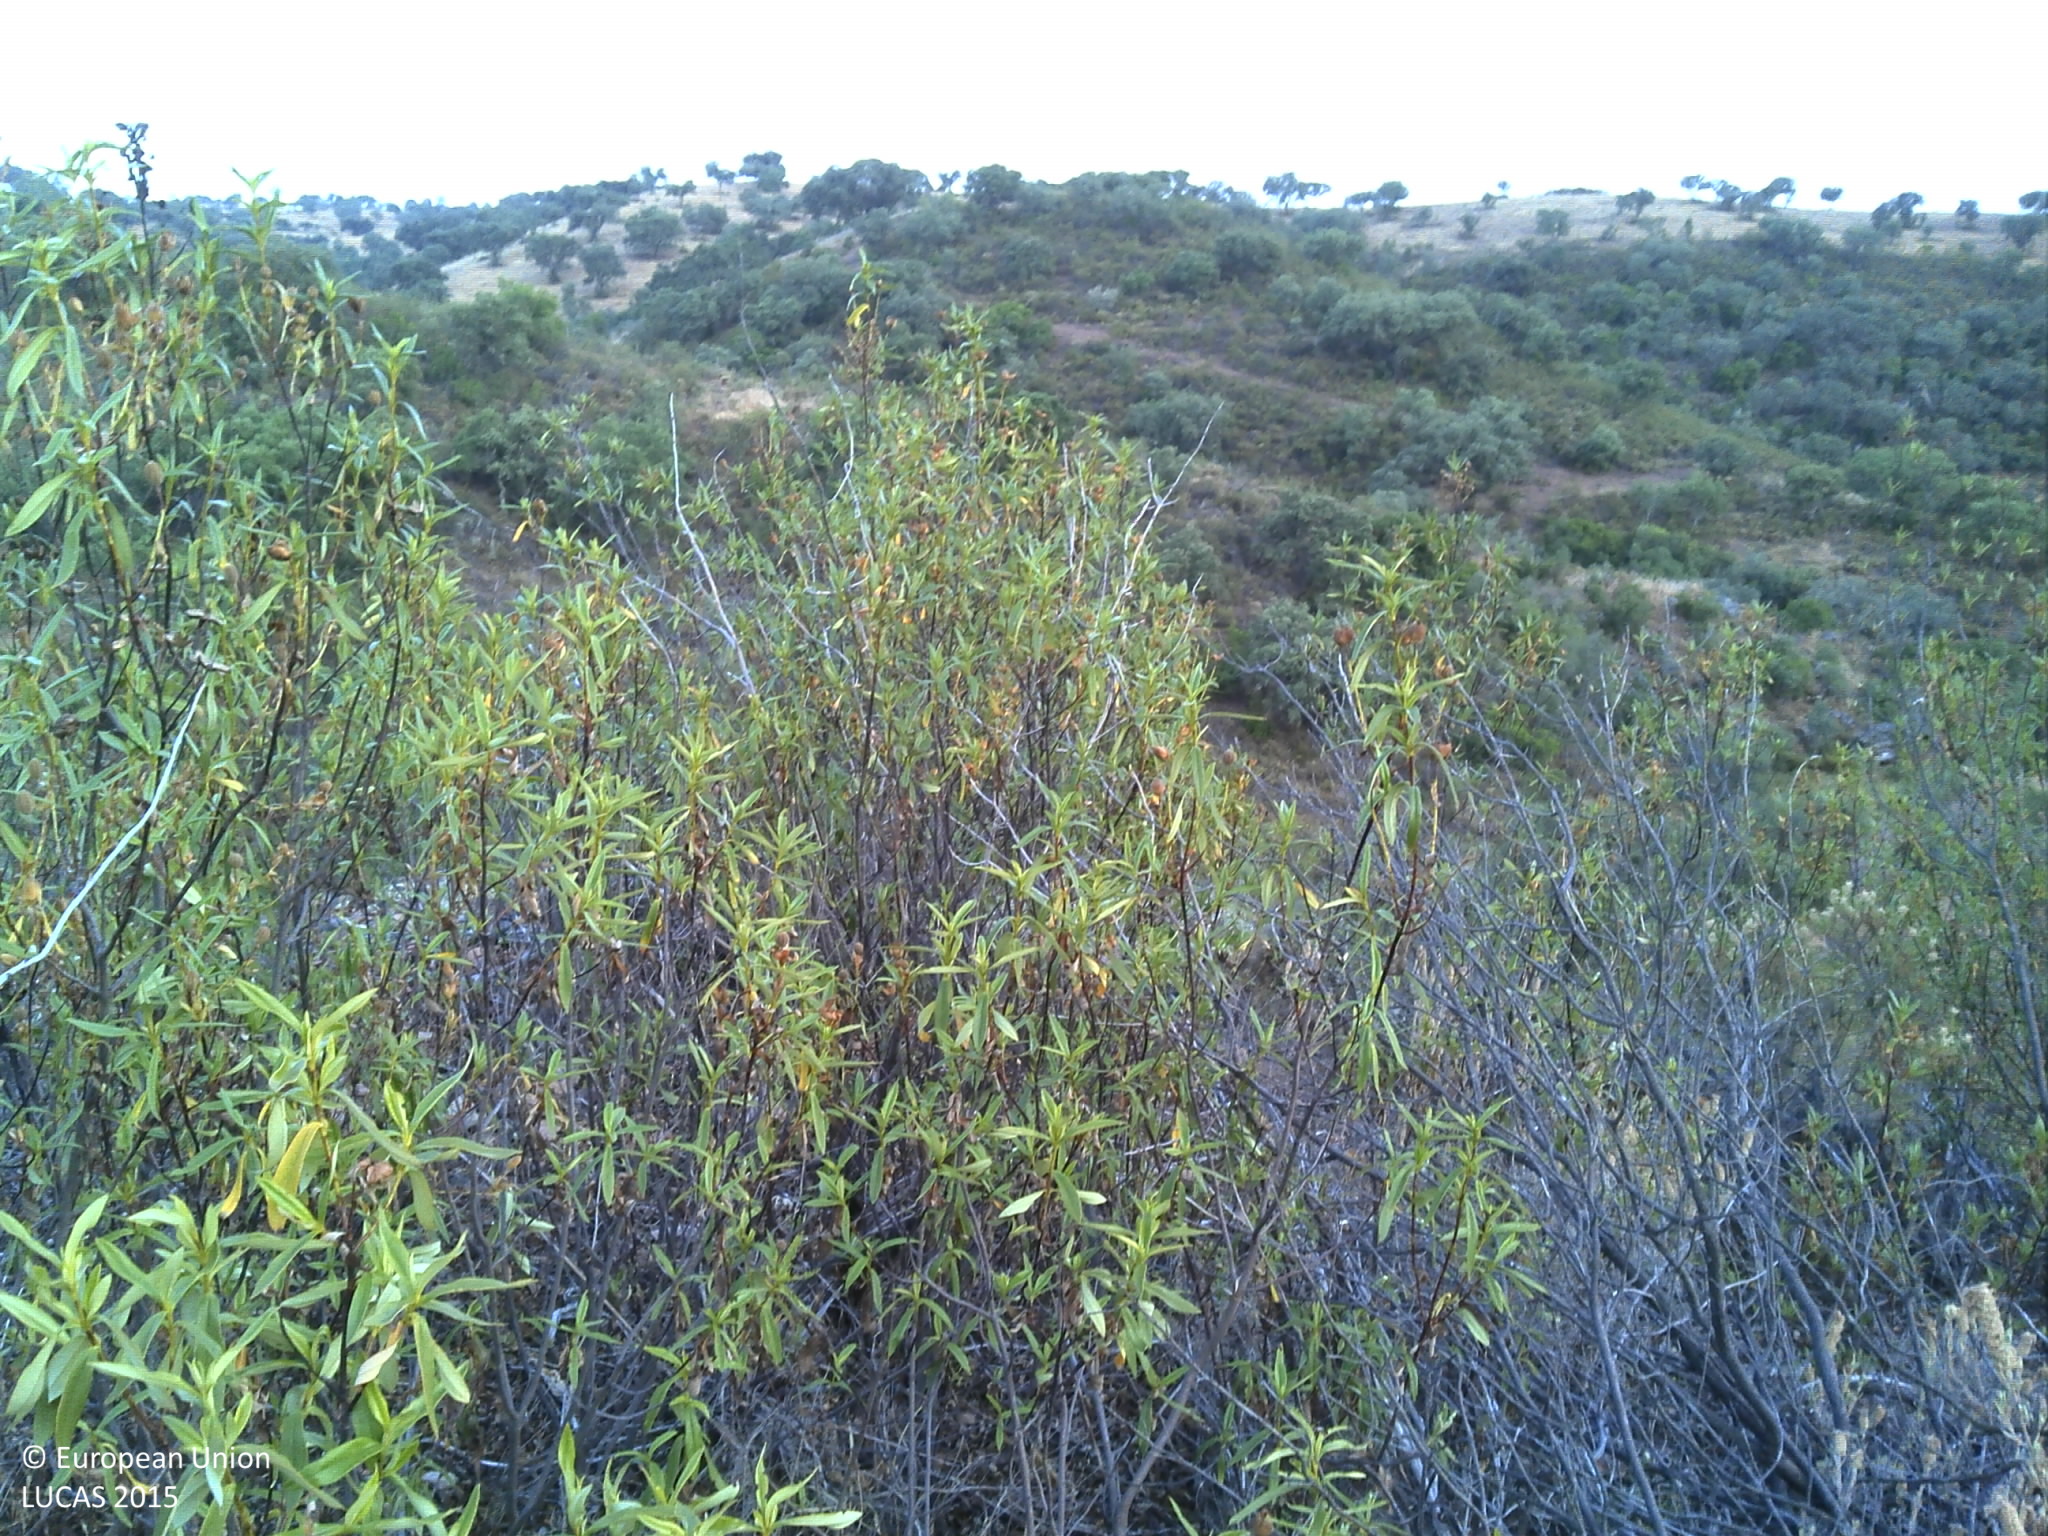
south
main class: Shrubland
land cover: Shrubland without tree cover
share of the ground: > 75 %
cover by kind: shrubs 90 %, unconsolidated bare surface 10 %
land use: Semi-natural and natural areas not in use
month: June
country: PT
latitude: 37.7880
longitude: -7.6299
